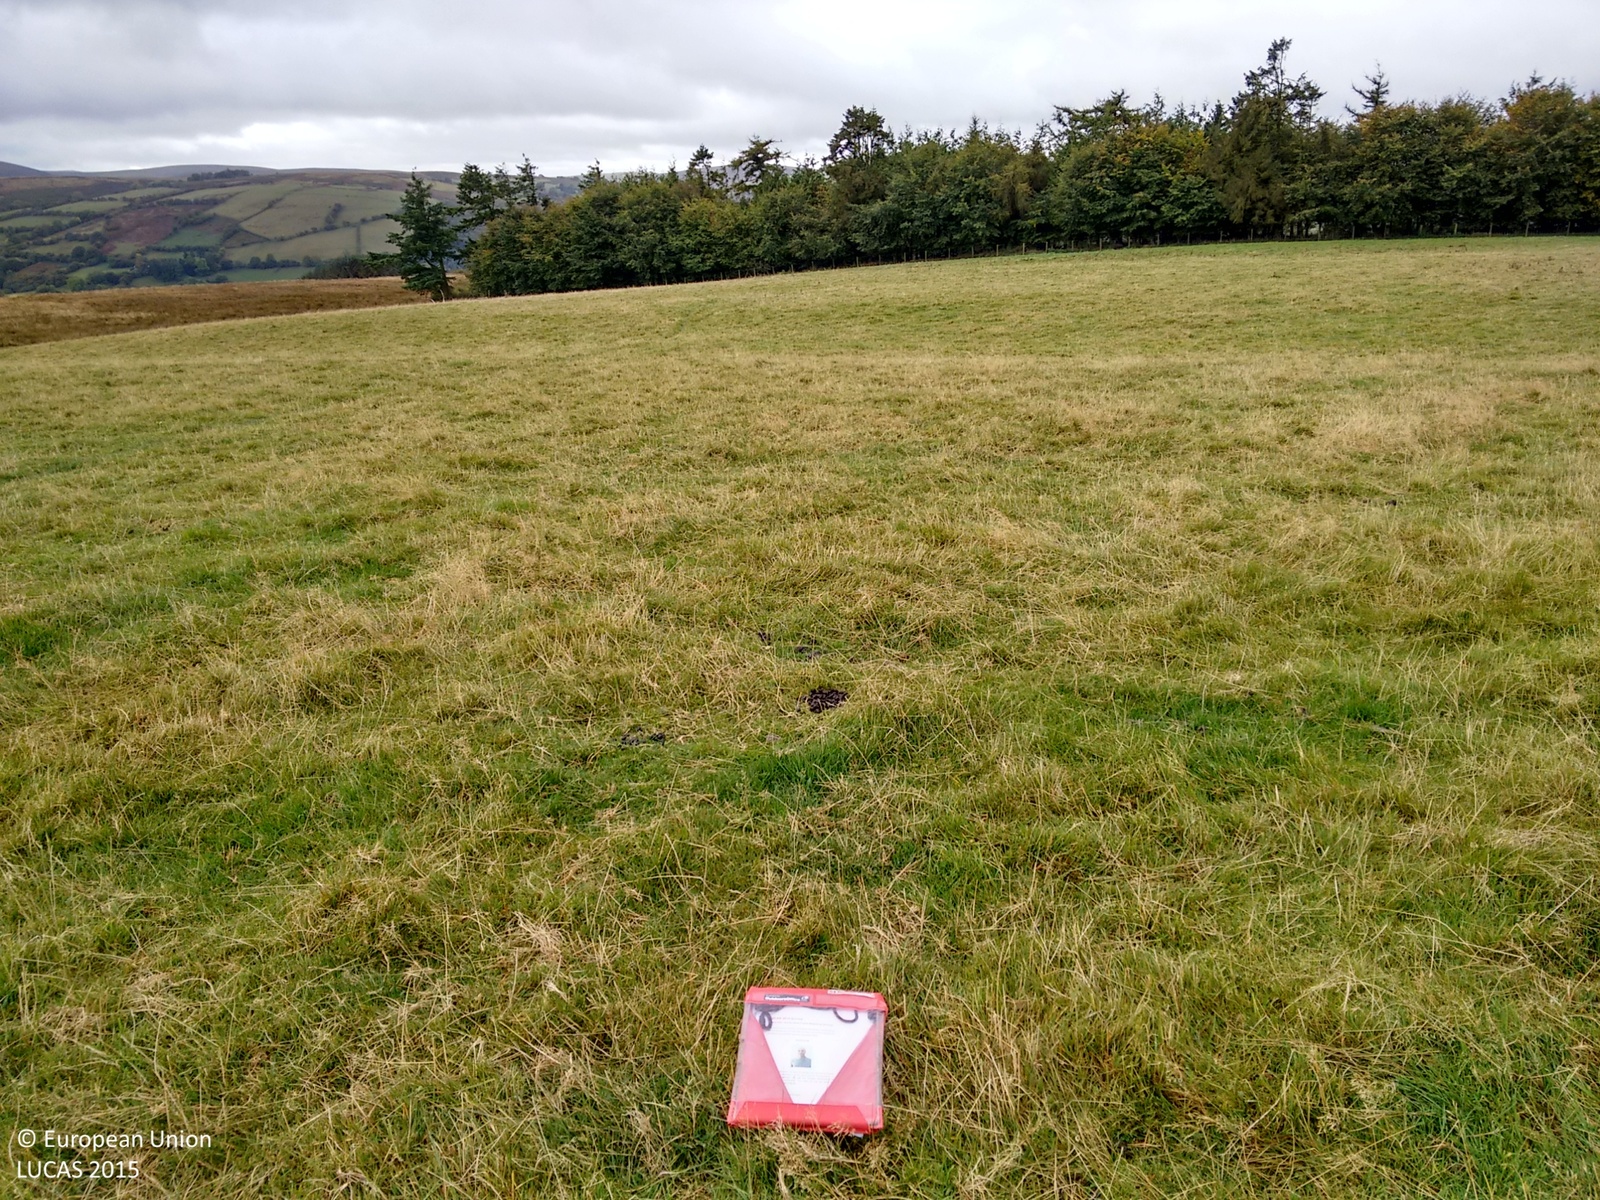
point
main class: Grassland
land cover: Grassland without tree/shrub cover
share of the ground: > 75 %
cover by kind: herbaceous plants 100 %
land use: Agriculture (excluding fallow land and kitchen gardens)
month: October
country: GB
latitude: 52.4365
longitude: -3.2146
